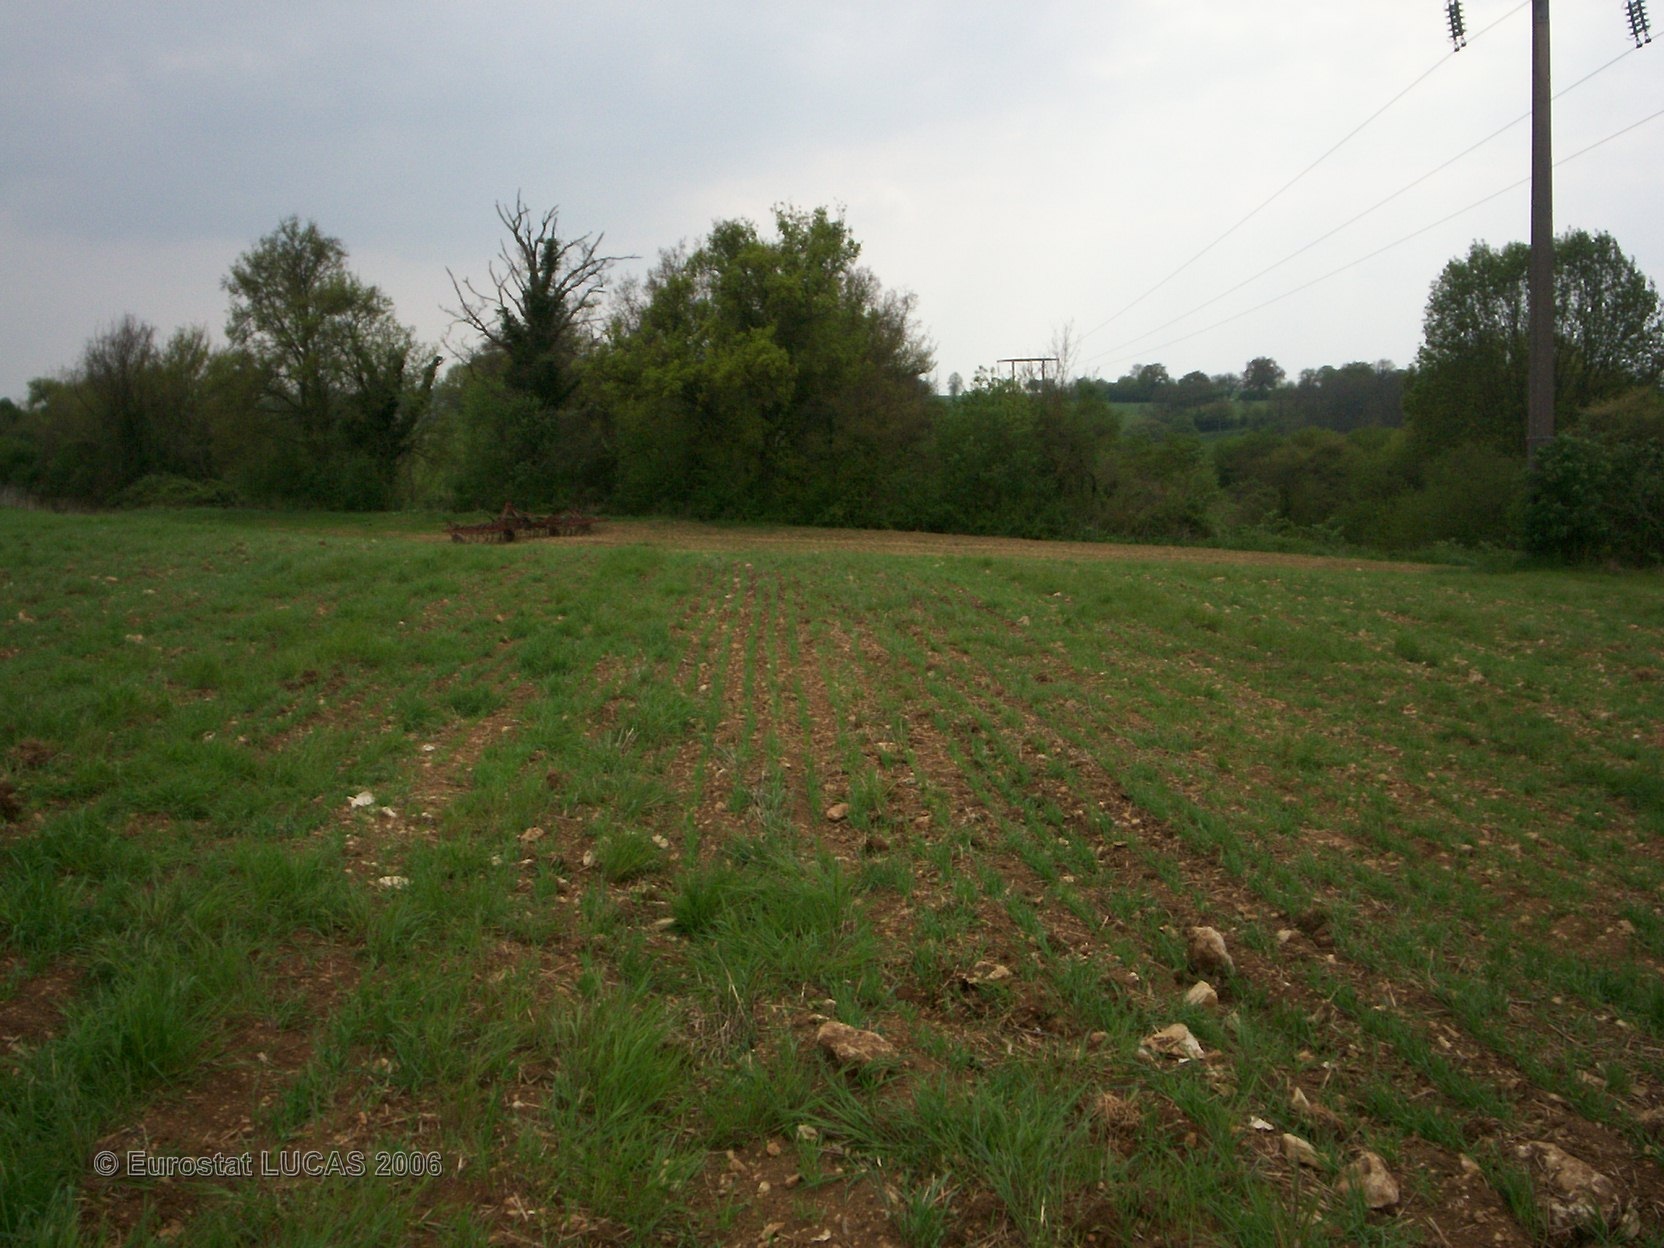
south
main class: Cropland
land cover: Barley
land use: Agriculture (excluding fallow land and kitchen gardens)
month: April
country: FR
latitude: 47.1189
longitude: 3.0495
